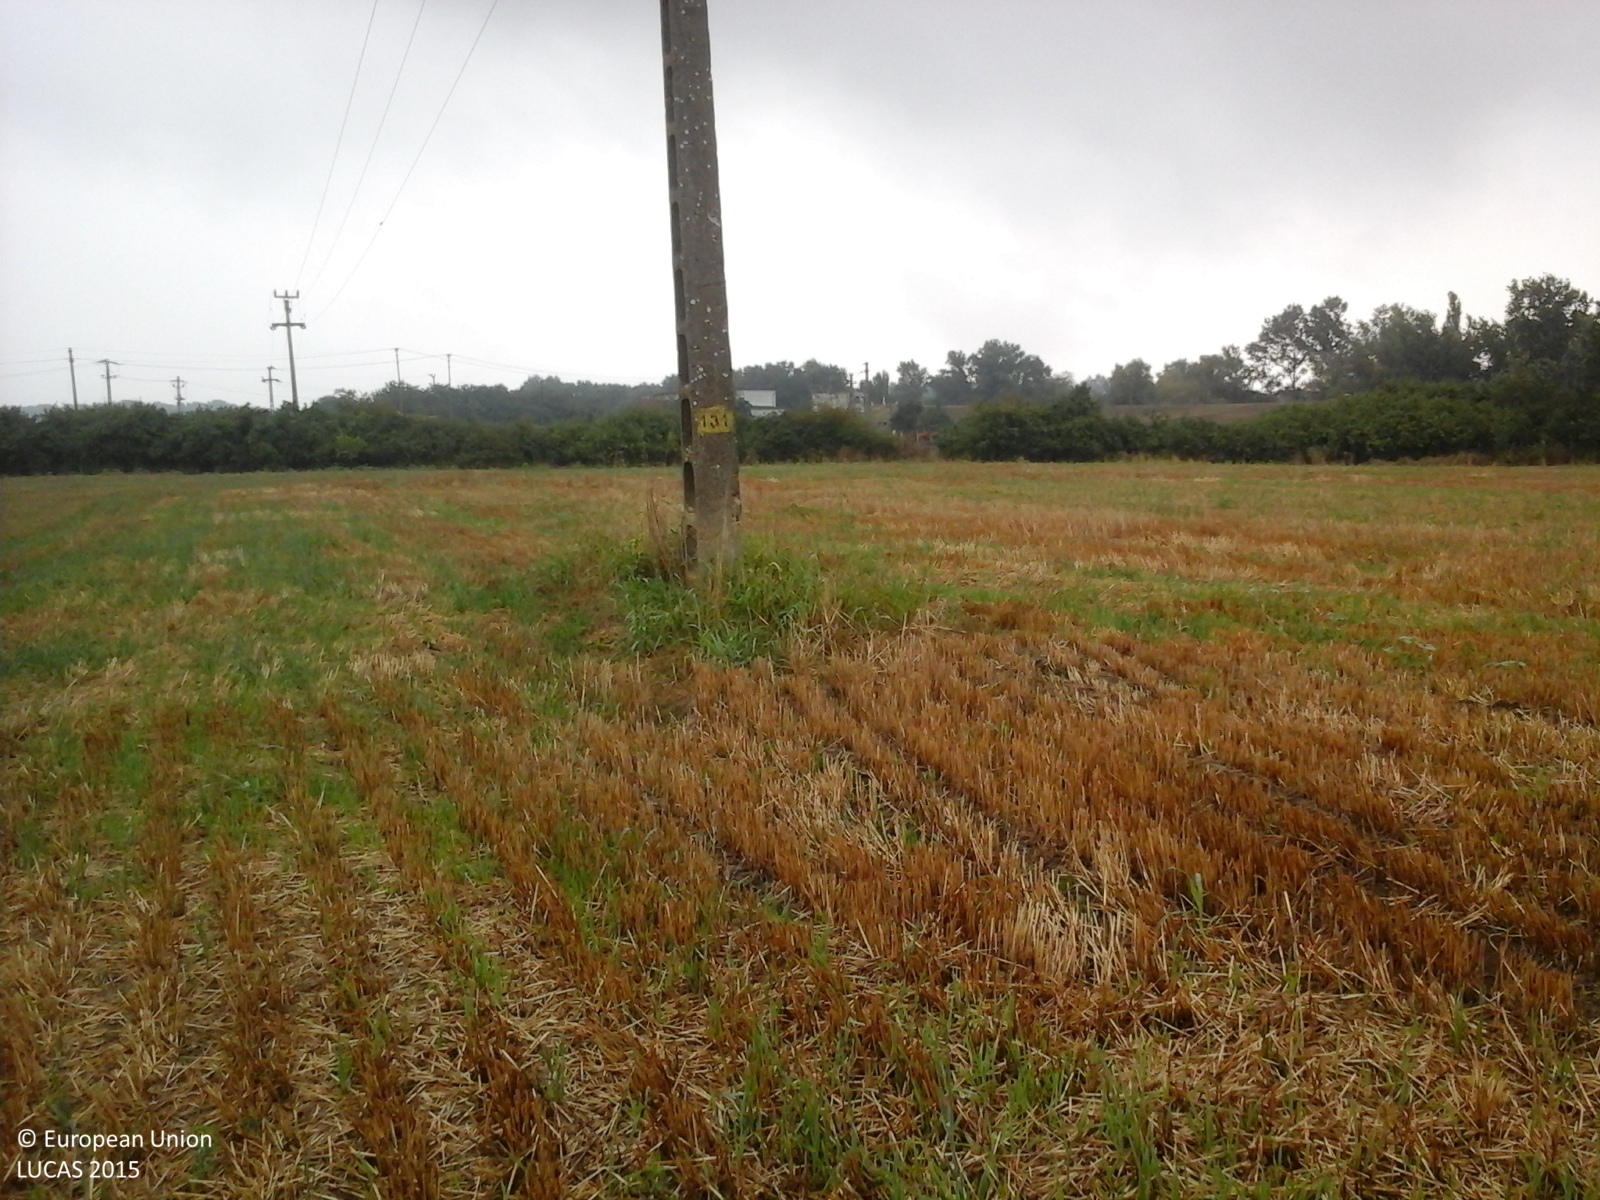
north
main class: Cropland
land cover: Durum wheat
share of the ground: < 10 %
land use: Agriculture (excluding fallow land and kitchen gardens)
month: August
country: RO
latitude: 46.1775
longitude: 20.5047
